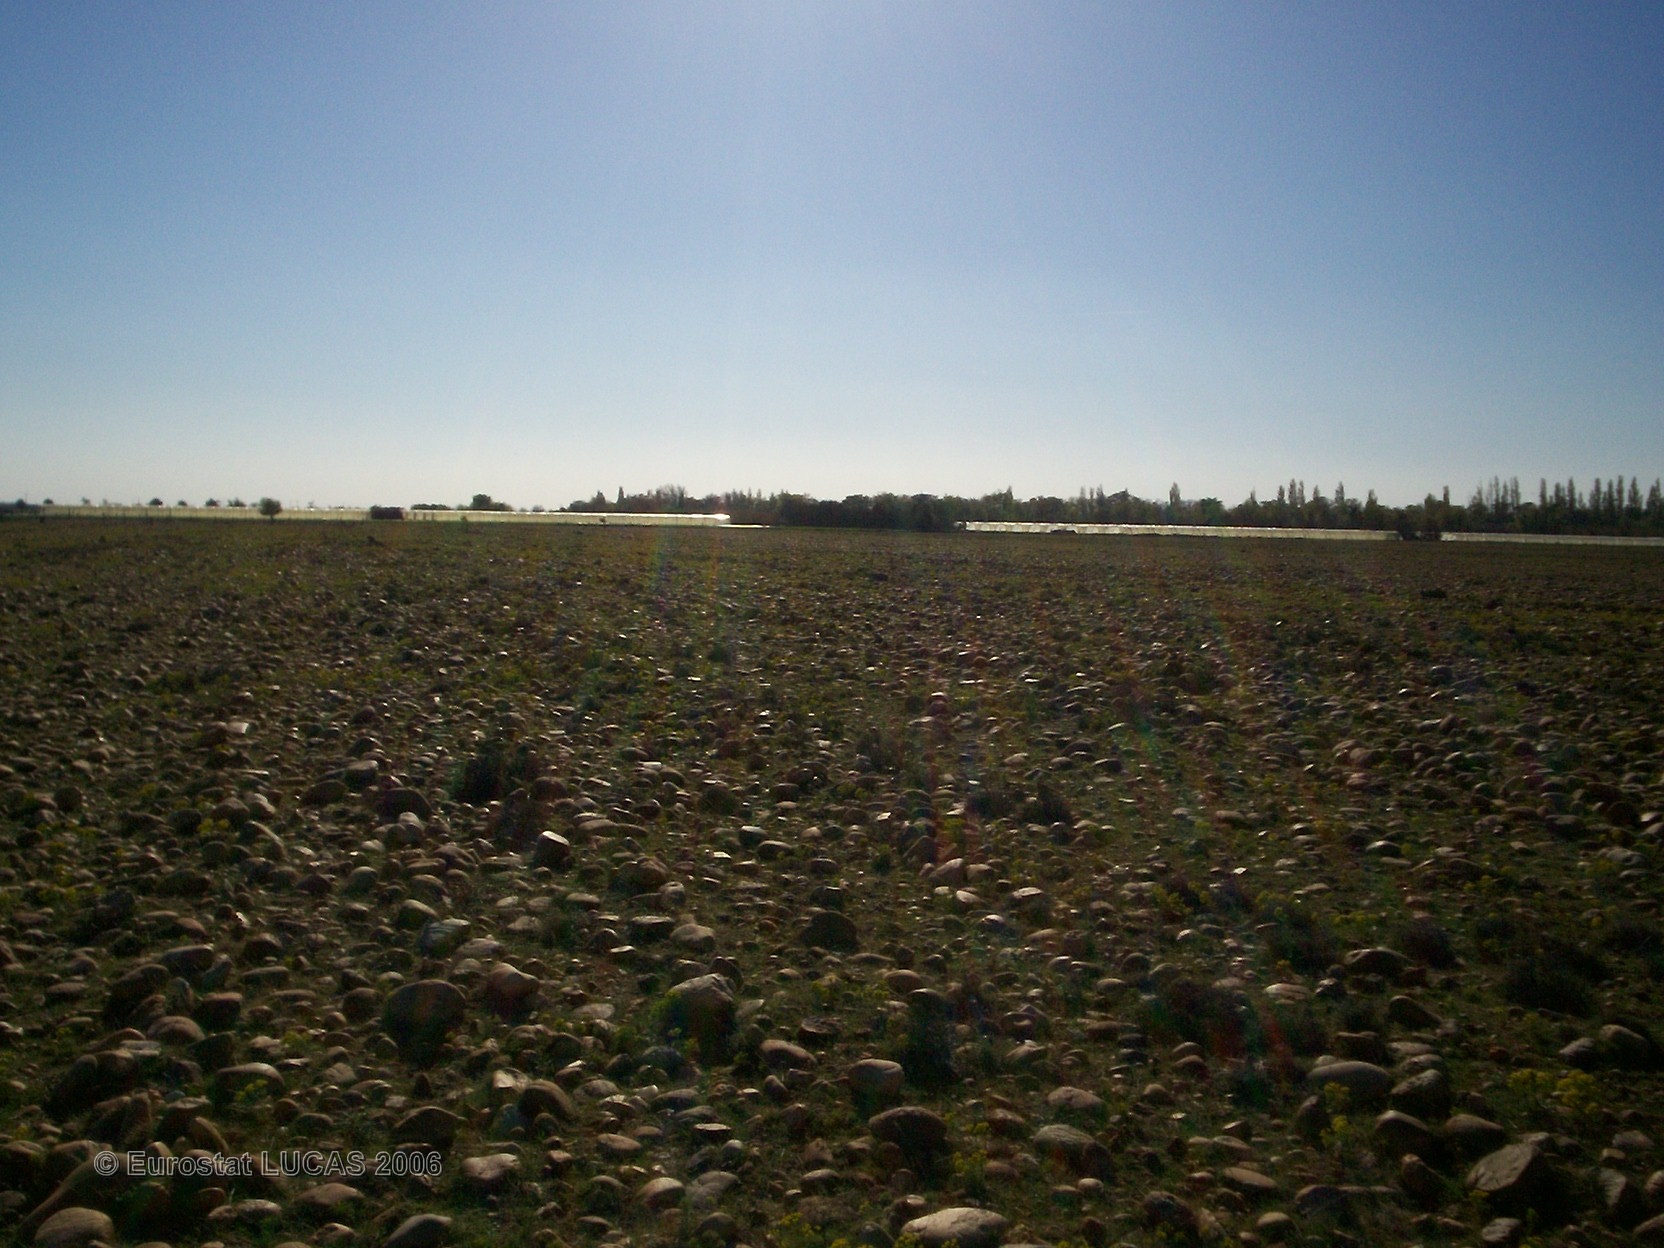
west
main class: Bare land
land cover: Bare land
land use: Unused
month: April
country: FR
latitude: 43.5767
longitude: 4.9450
